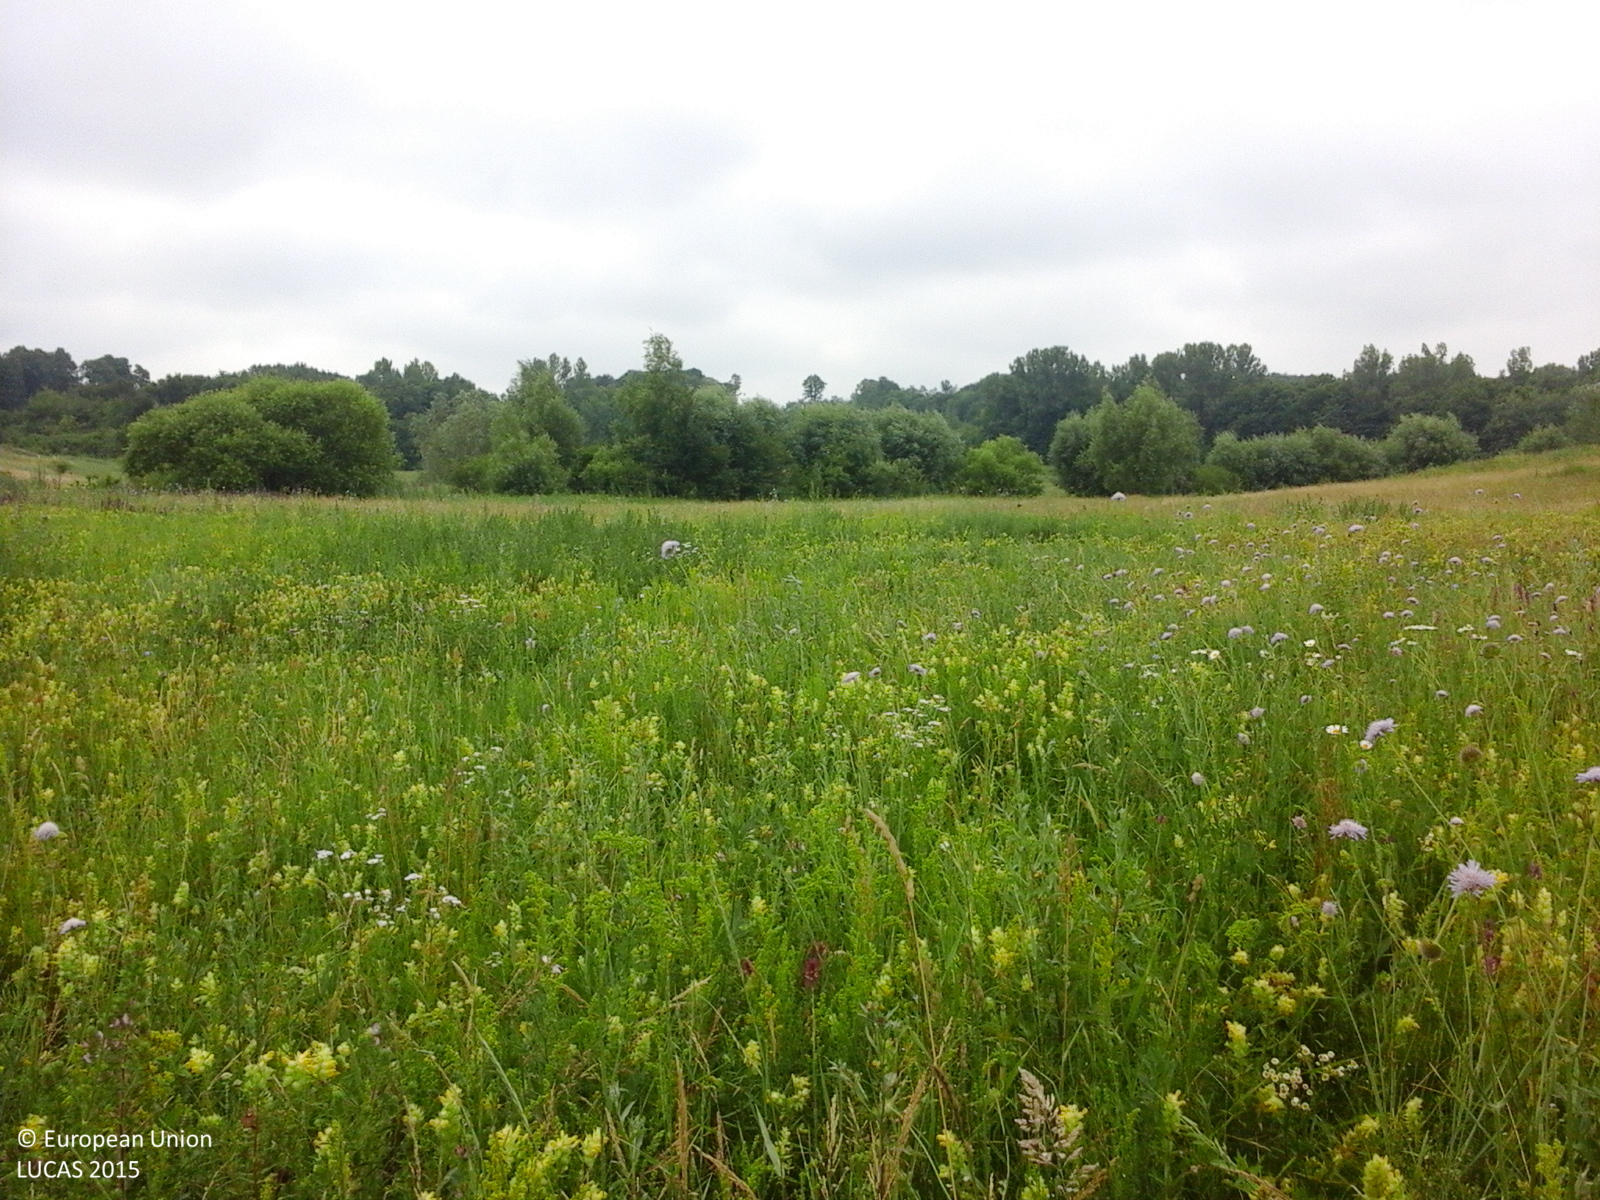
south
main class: Grassland
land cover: Grassland without tree/shrub cover
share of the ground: > 75 %
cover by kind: herbaceous plants 100 %
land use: Agriculture (excluding fallow land and kitchen gardens)
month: June
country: RO
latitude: 47.5641
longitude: 26.4496
